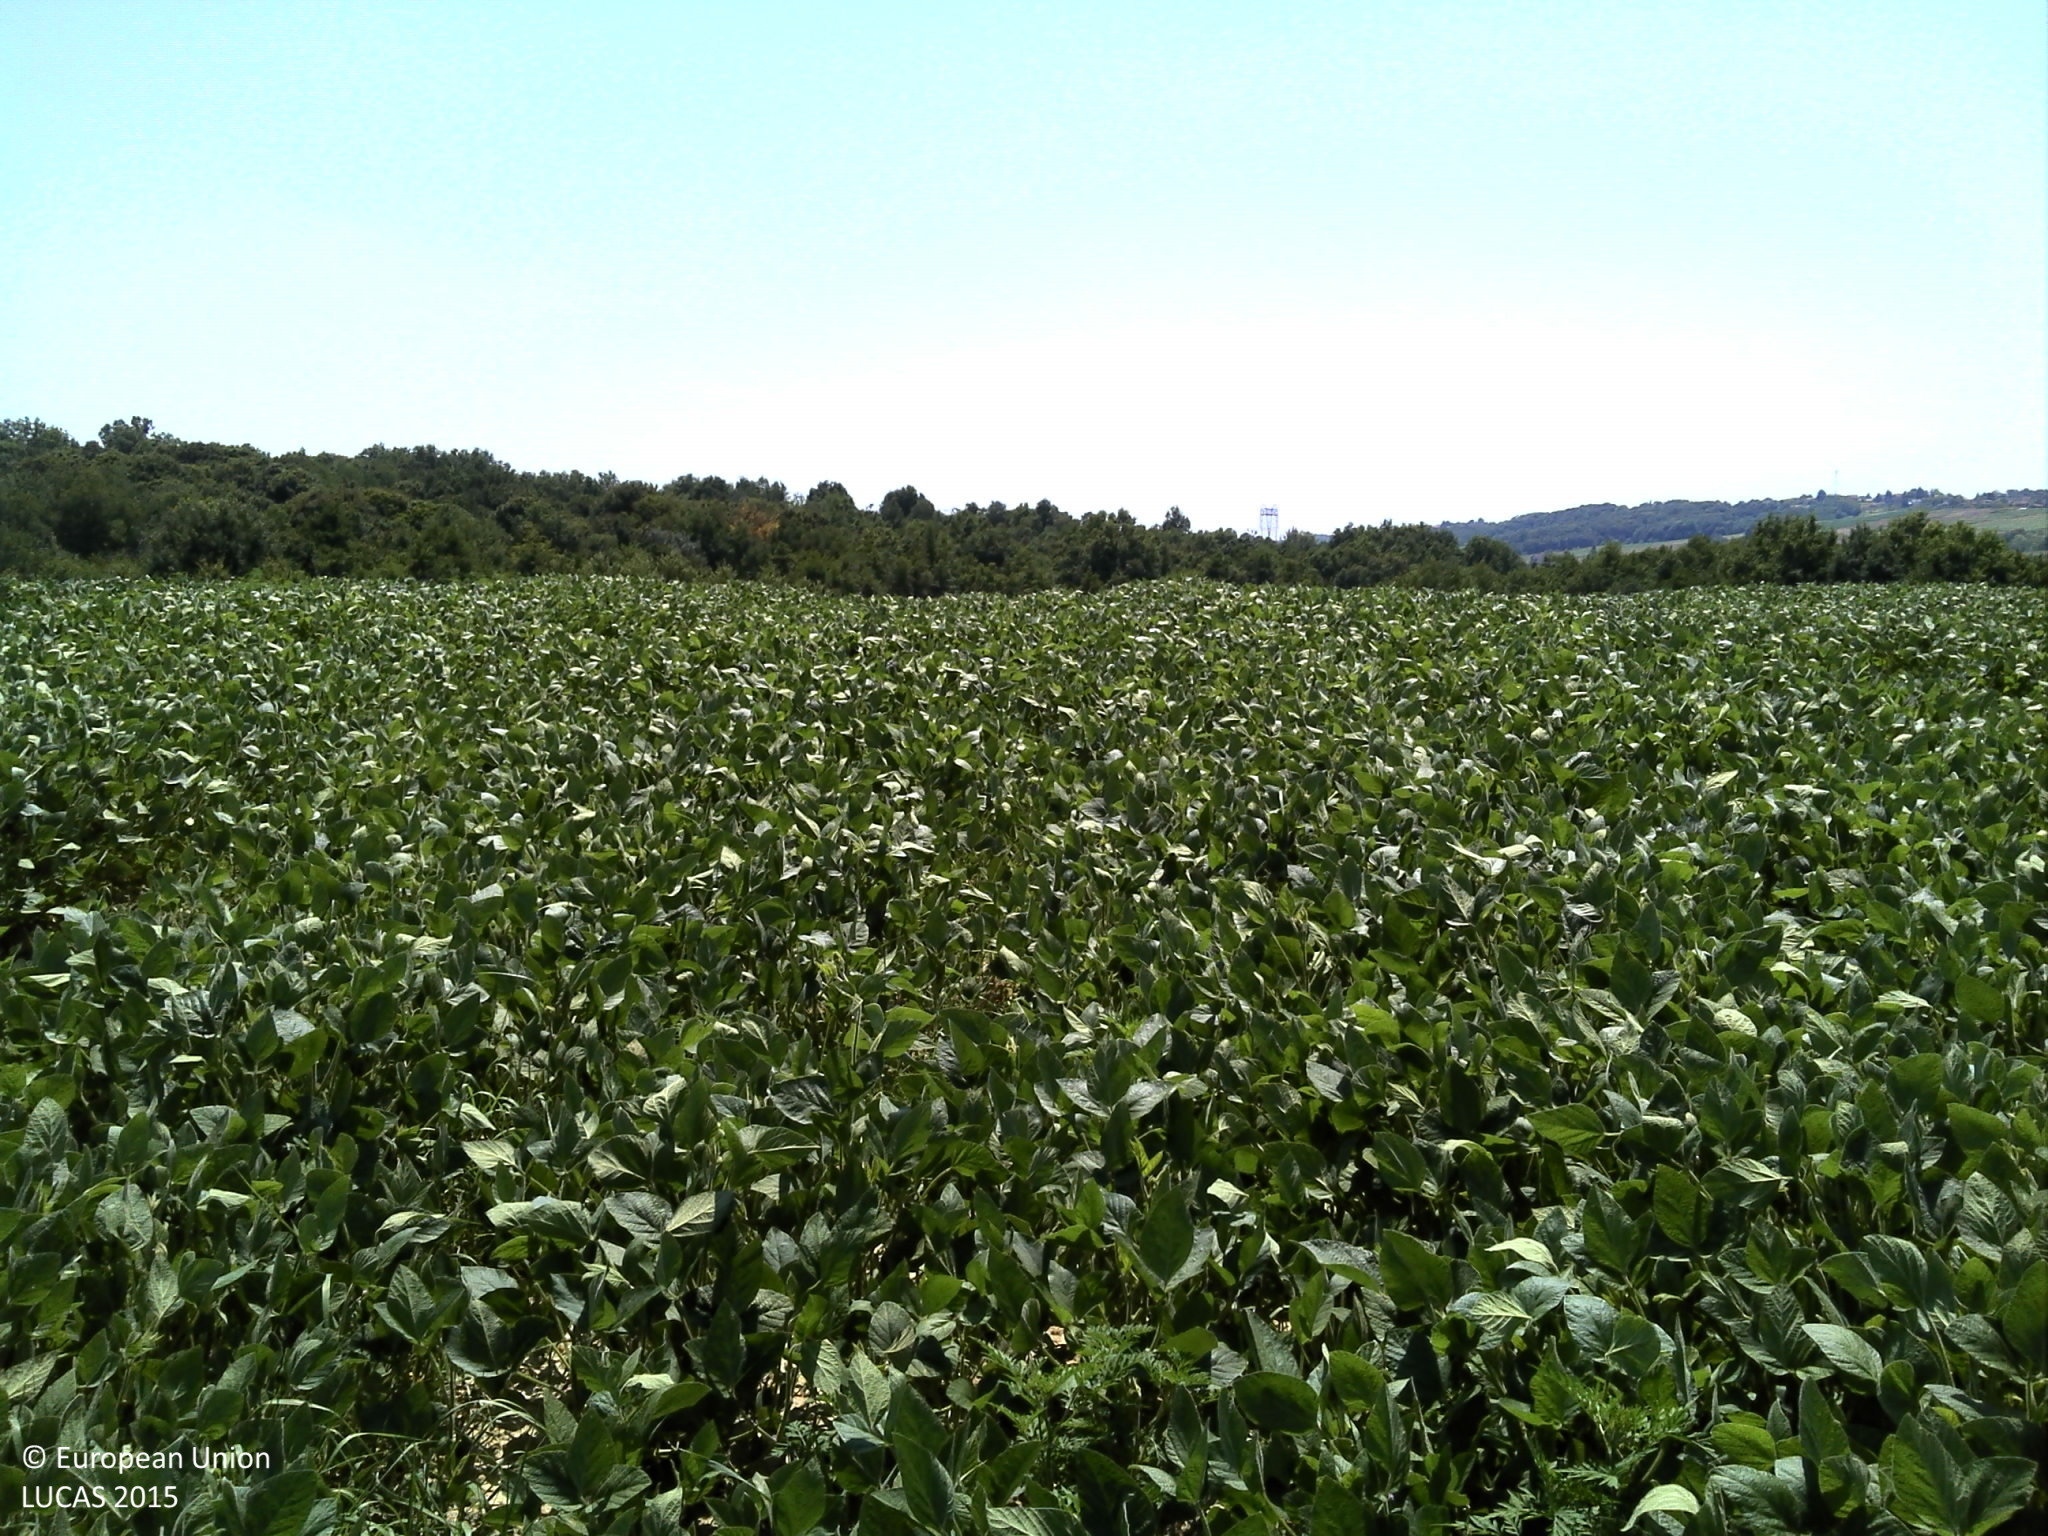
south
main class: Cropland
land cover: Soya
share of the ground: 50 - 75 %
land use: Agriculture (excluding fallow land and kitchen gardens)
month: July
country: HR
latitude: 45.5382
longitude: 16.7993
